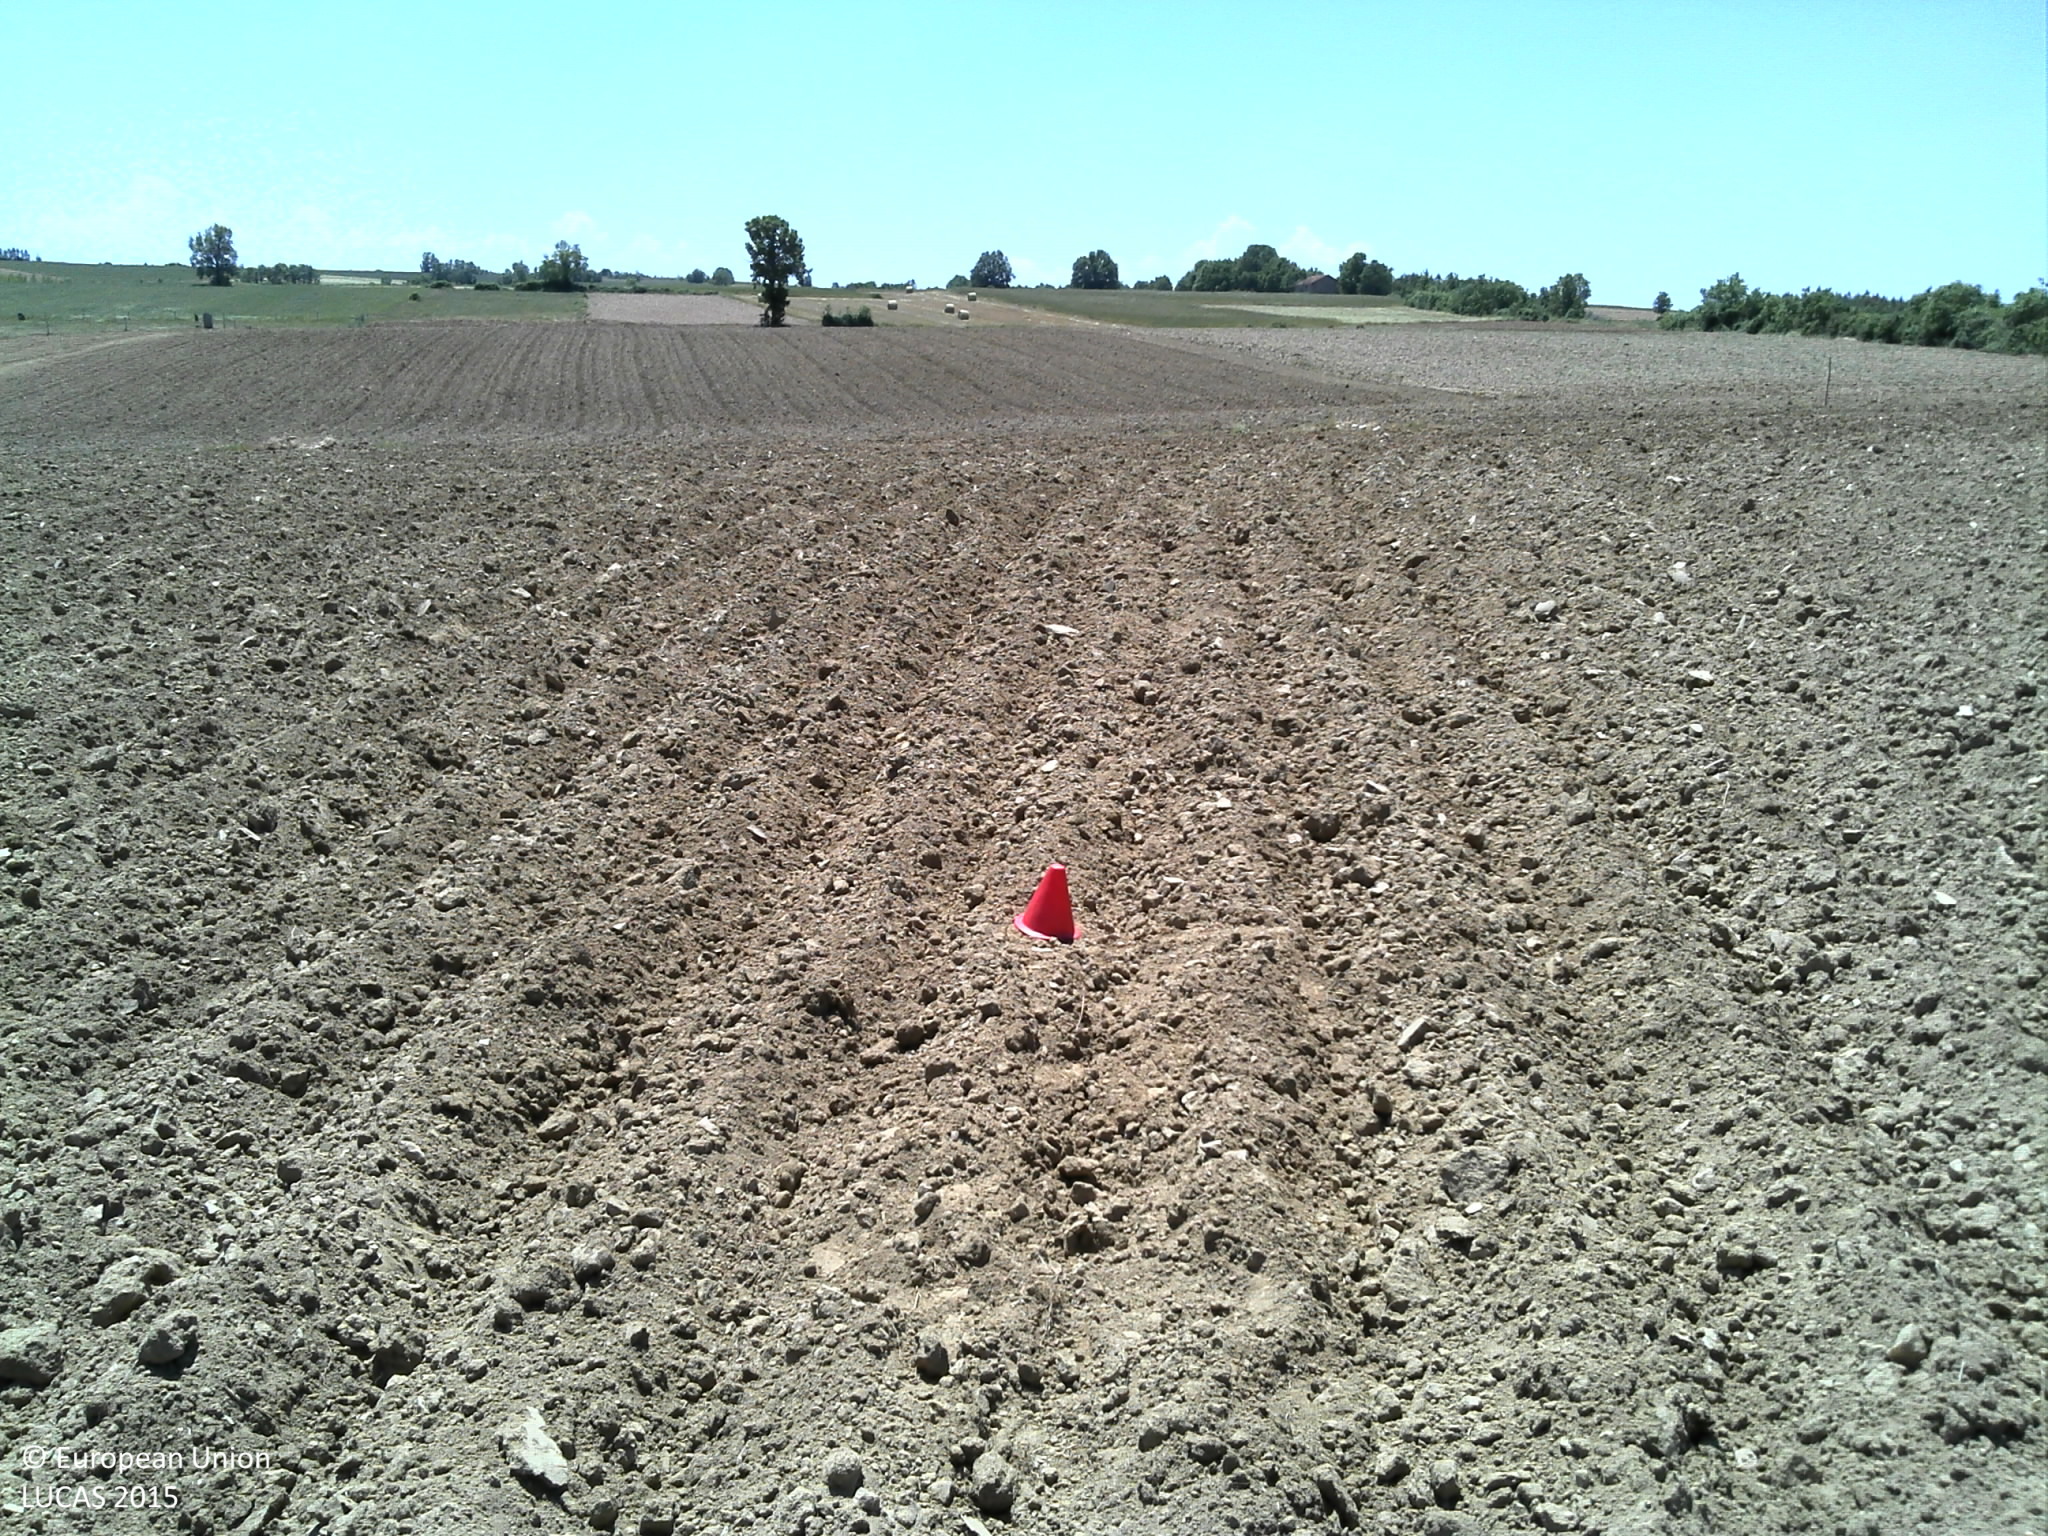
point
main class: Cropland
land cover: Oats
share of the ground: < 10 %
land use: Agriculture (excluding fallow land and kitchen gardens)
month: May
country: PT
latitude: 41.5371
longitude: -6.3411
